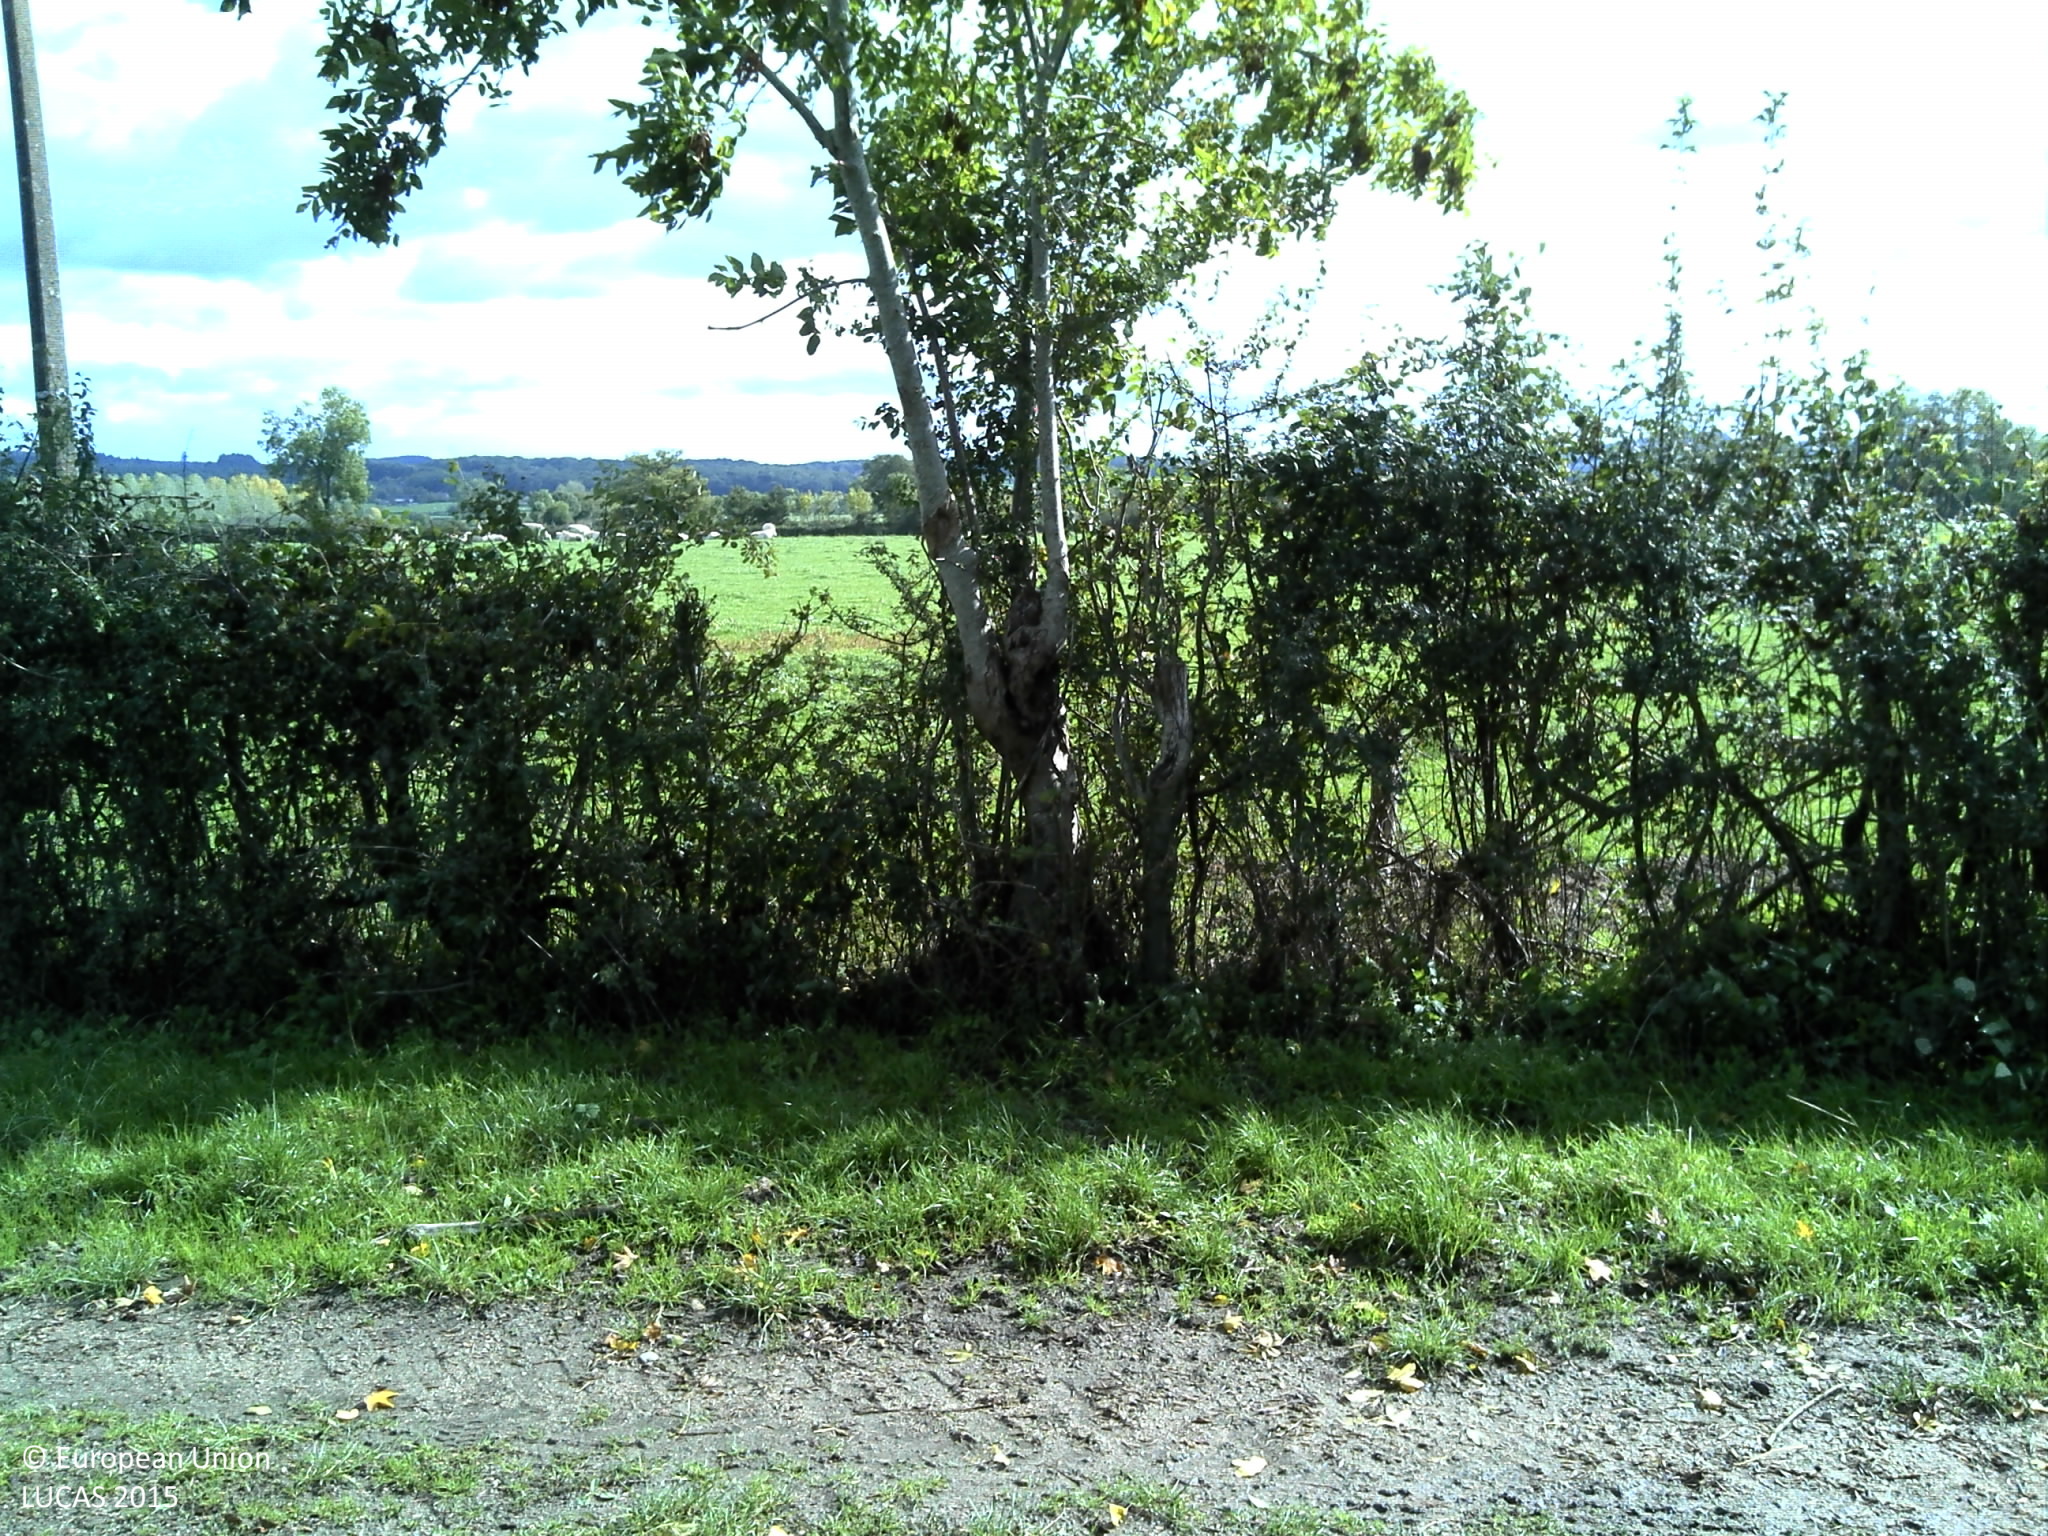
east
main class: Grassland
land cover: Grassland without tree/shrub cover
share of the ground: > 75 %
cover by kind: herbaceous plants 100 %
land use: Agriculture (excluding fallow land and kitchen gardens)
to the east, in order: Managed hedges; Fences; Grassland without tree/shrub cover; Fences; Managed hedges; Tracks; Managed hedges; Fences; Grassland without tree/shrub cover; Electric lines; Grassland without tree/shrub cover; Fences; Grassland without tree/shrub cover
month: October
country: FR
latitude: 46.6194
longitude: 4.0583
